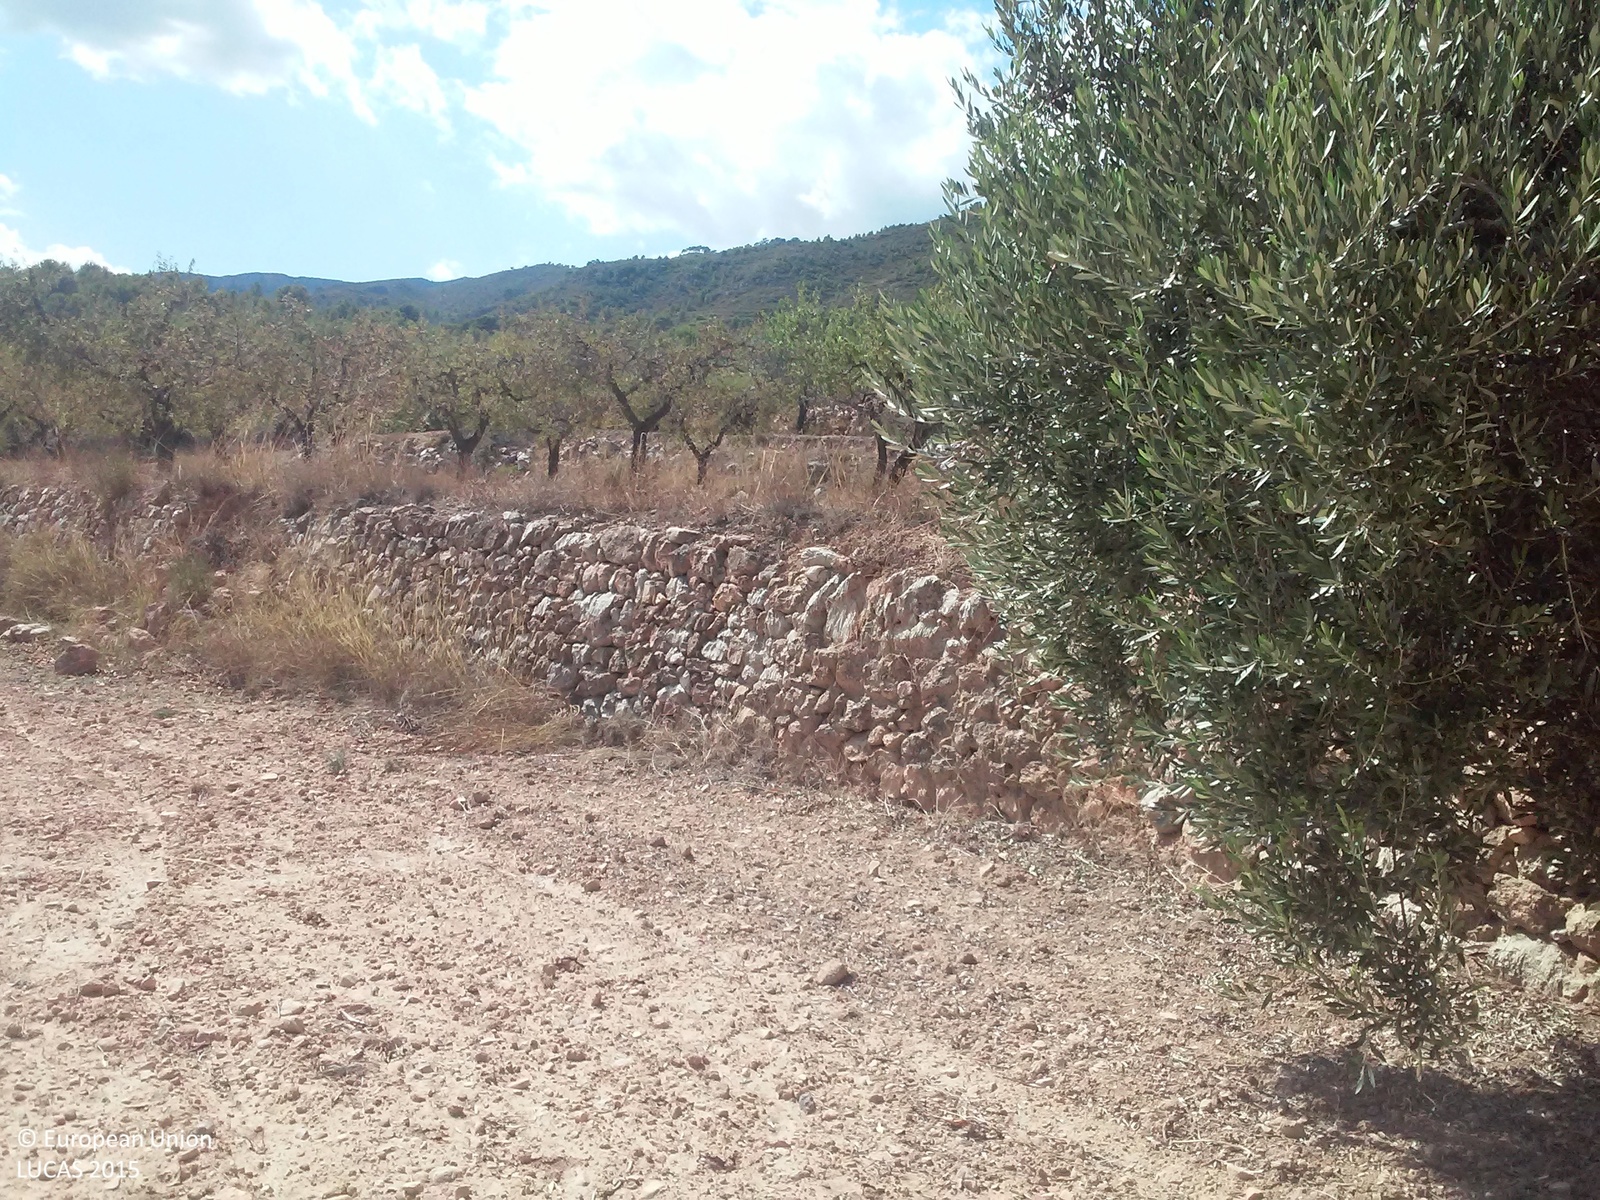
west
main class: Cropland
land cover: Olive groves
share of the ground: < 10 %
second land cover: Other bare soil
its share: > 75 %
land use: Agriculture (excluding fallow land and kitchen gardens)
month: August
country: ES
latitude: 41.0664
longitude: 0.5548
